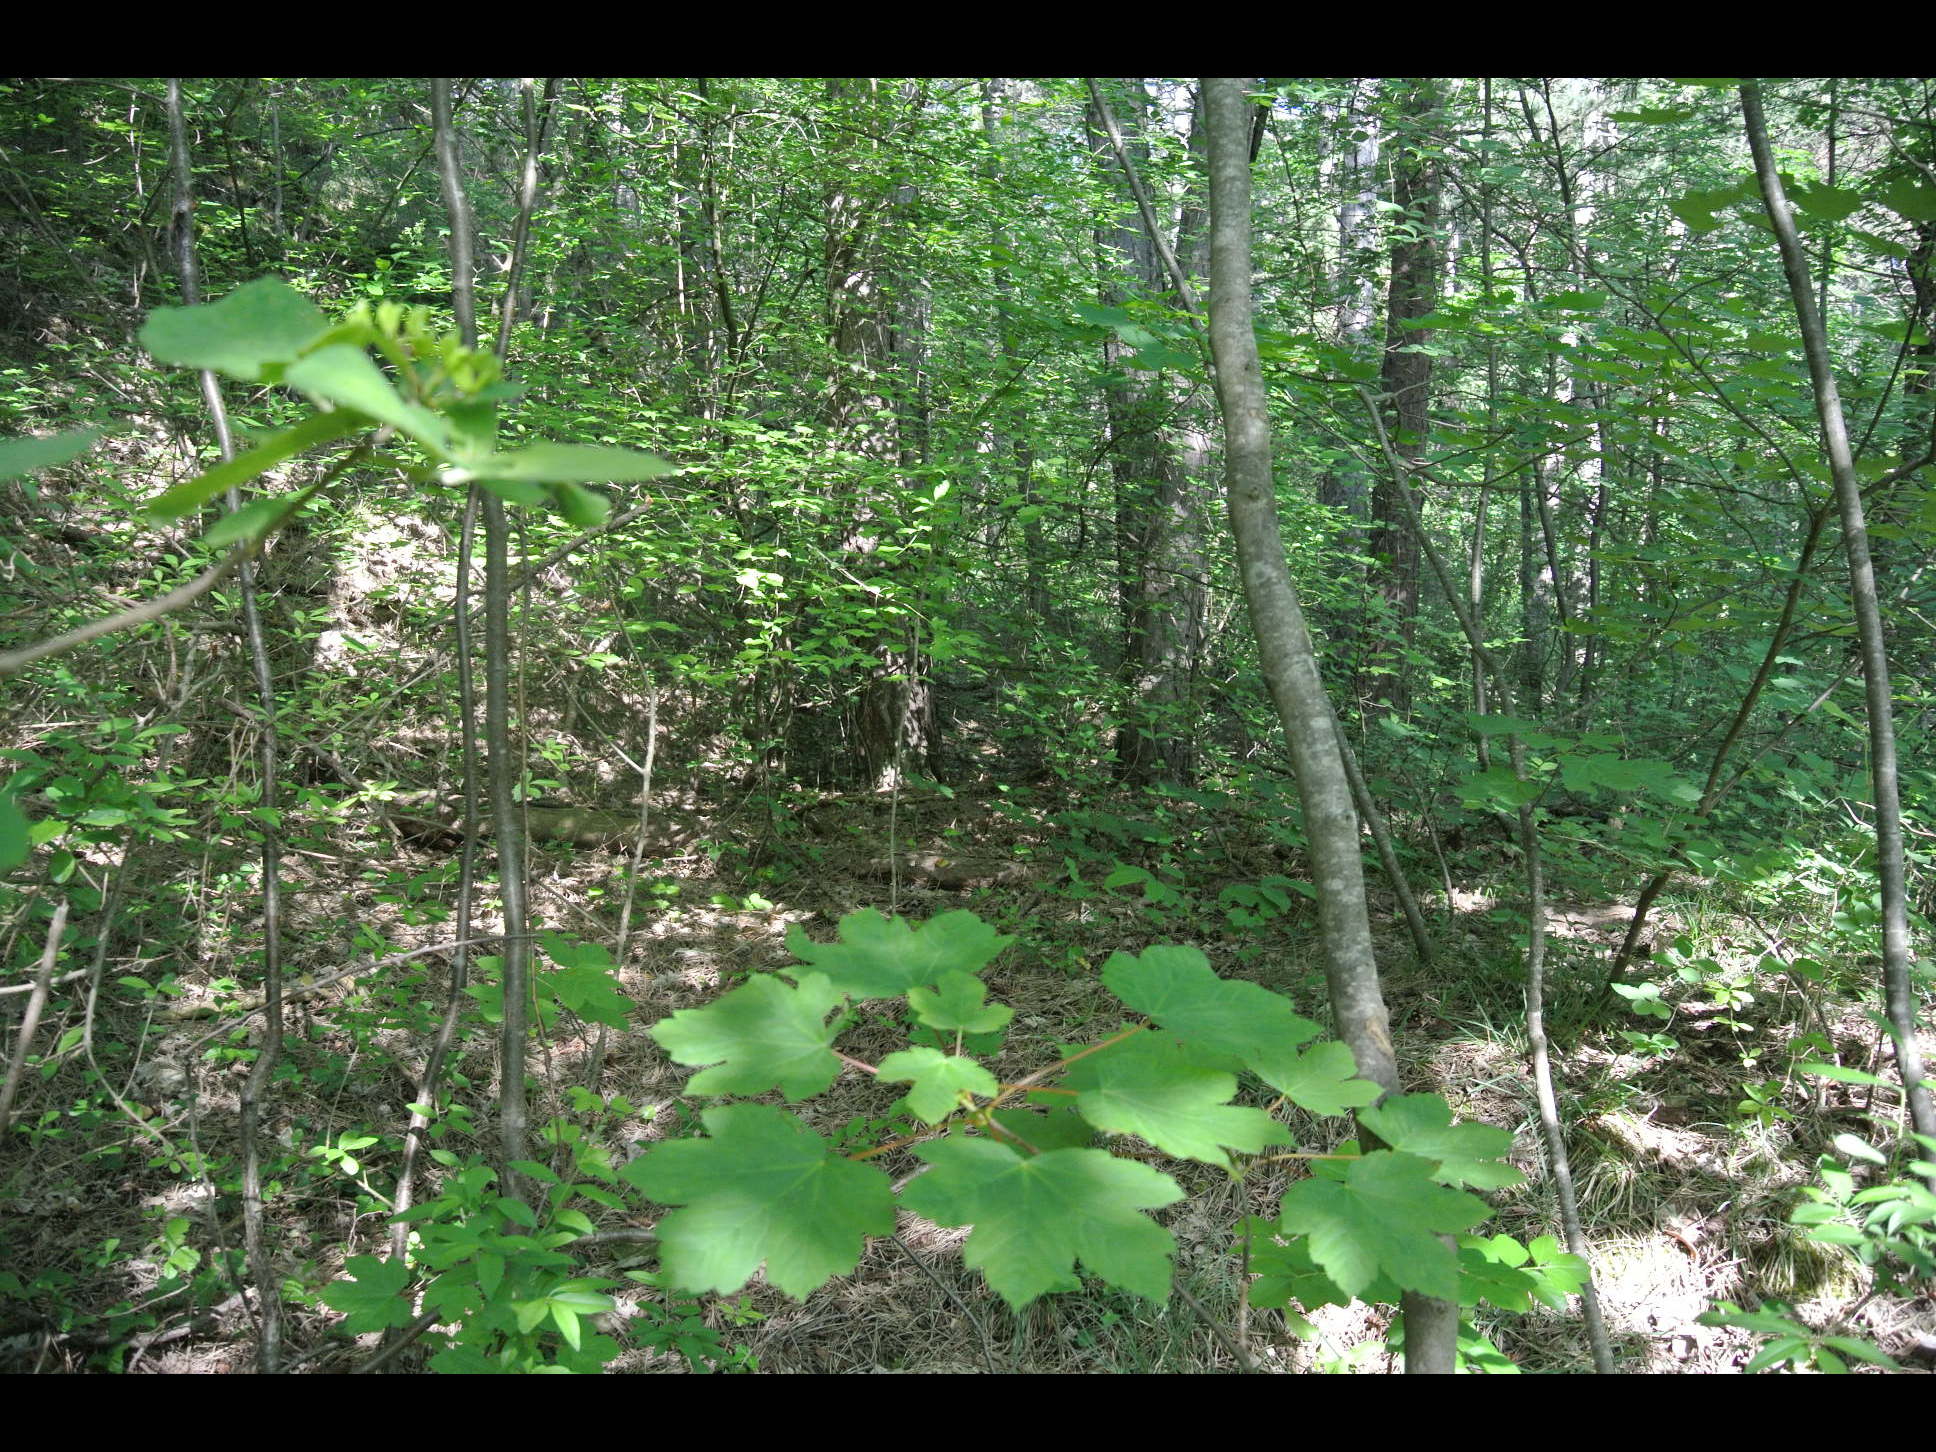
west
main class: Woodland
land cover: Pine dominated mixed woodland
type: alpine coniferous forest
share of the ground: > 75 %
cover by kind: broadleaved forest trees 75 %, coniferous forest trees 25 %
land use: Forestry
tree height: > 5 m
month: May
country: AT
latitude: 47.8346
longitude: 16.1625
